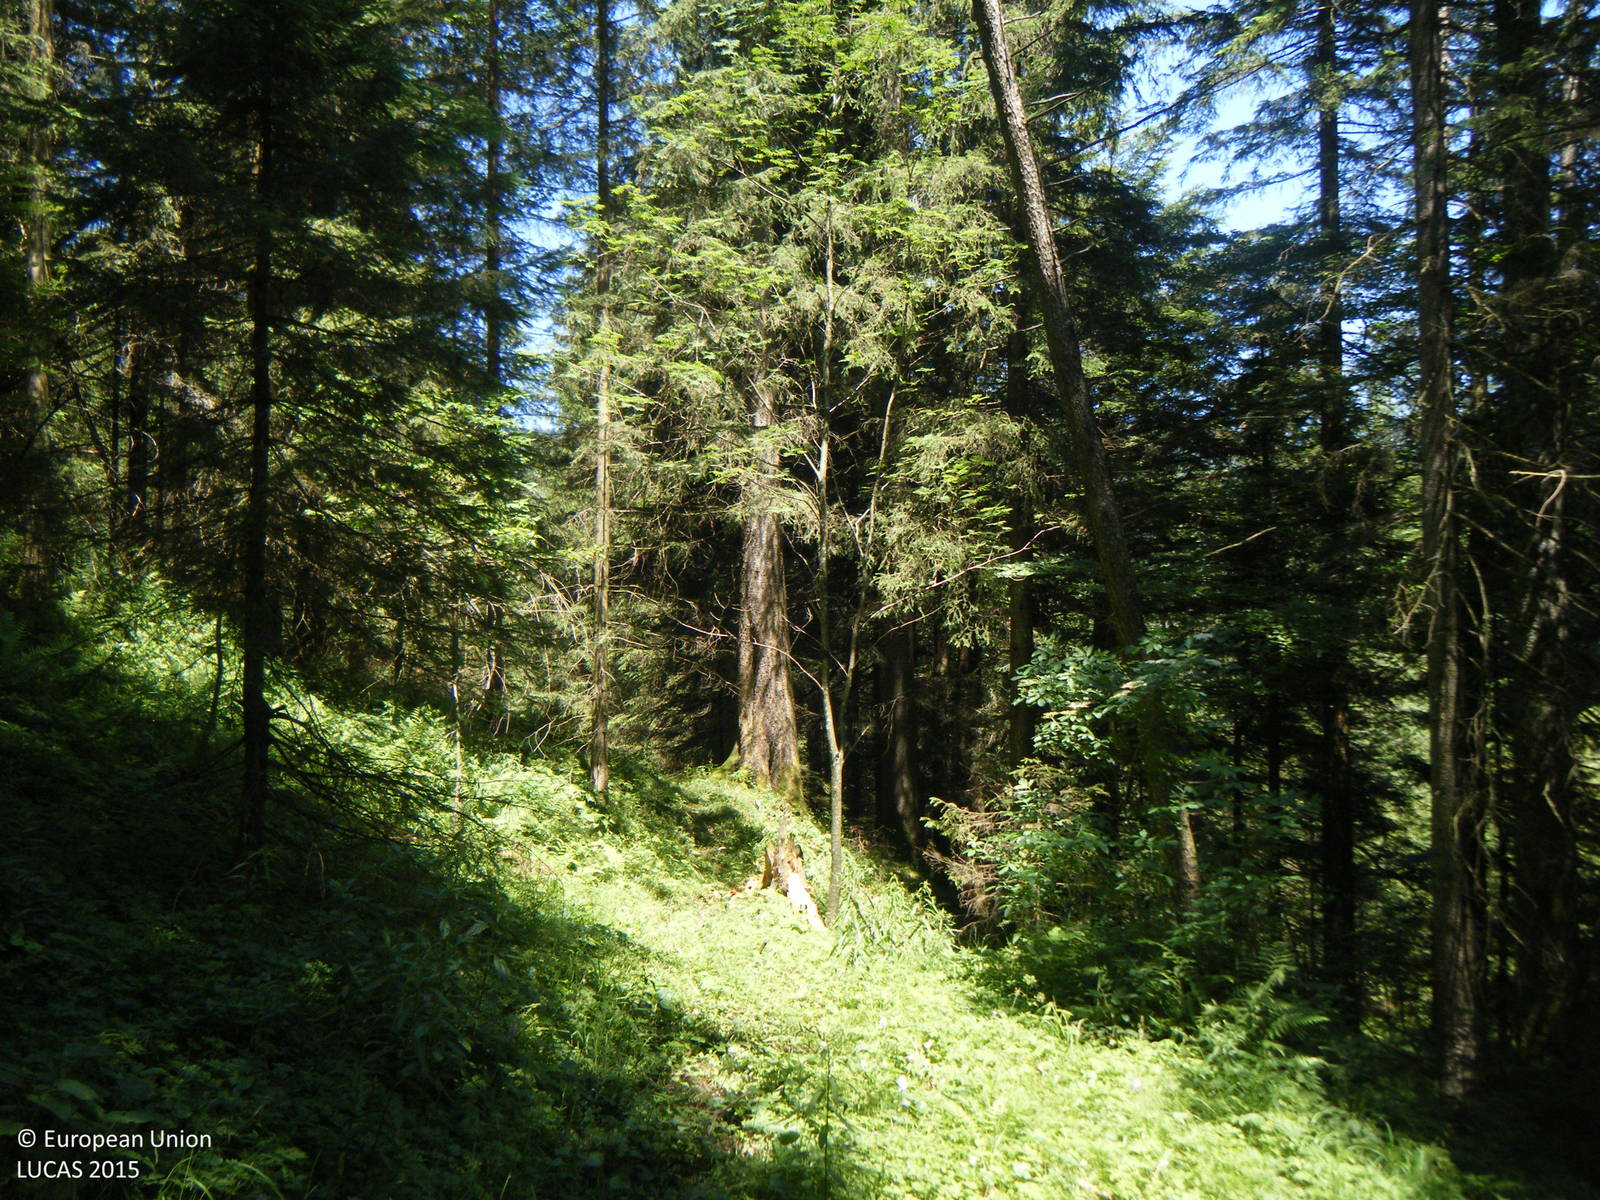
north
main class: Woodland
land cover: Spruce dominated mixed woodland
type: alpine coniferous forest
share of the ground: > 75 %
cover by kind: coniferous forest trees 60 %, broadleaved forest trees 25 %, herbaceous plants 15 %
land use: Forestry
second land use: Agriculture (excluding fallow land and kitchen gardens)
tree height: > 5 m
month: July
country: AT
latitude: 47.7593
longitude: 13.3205
